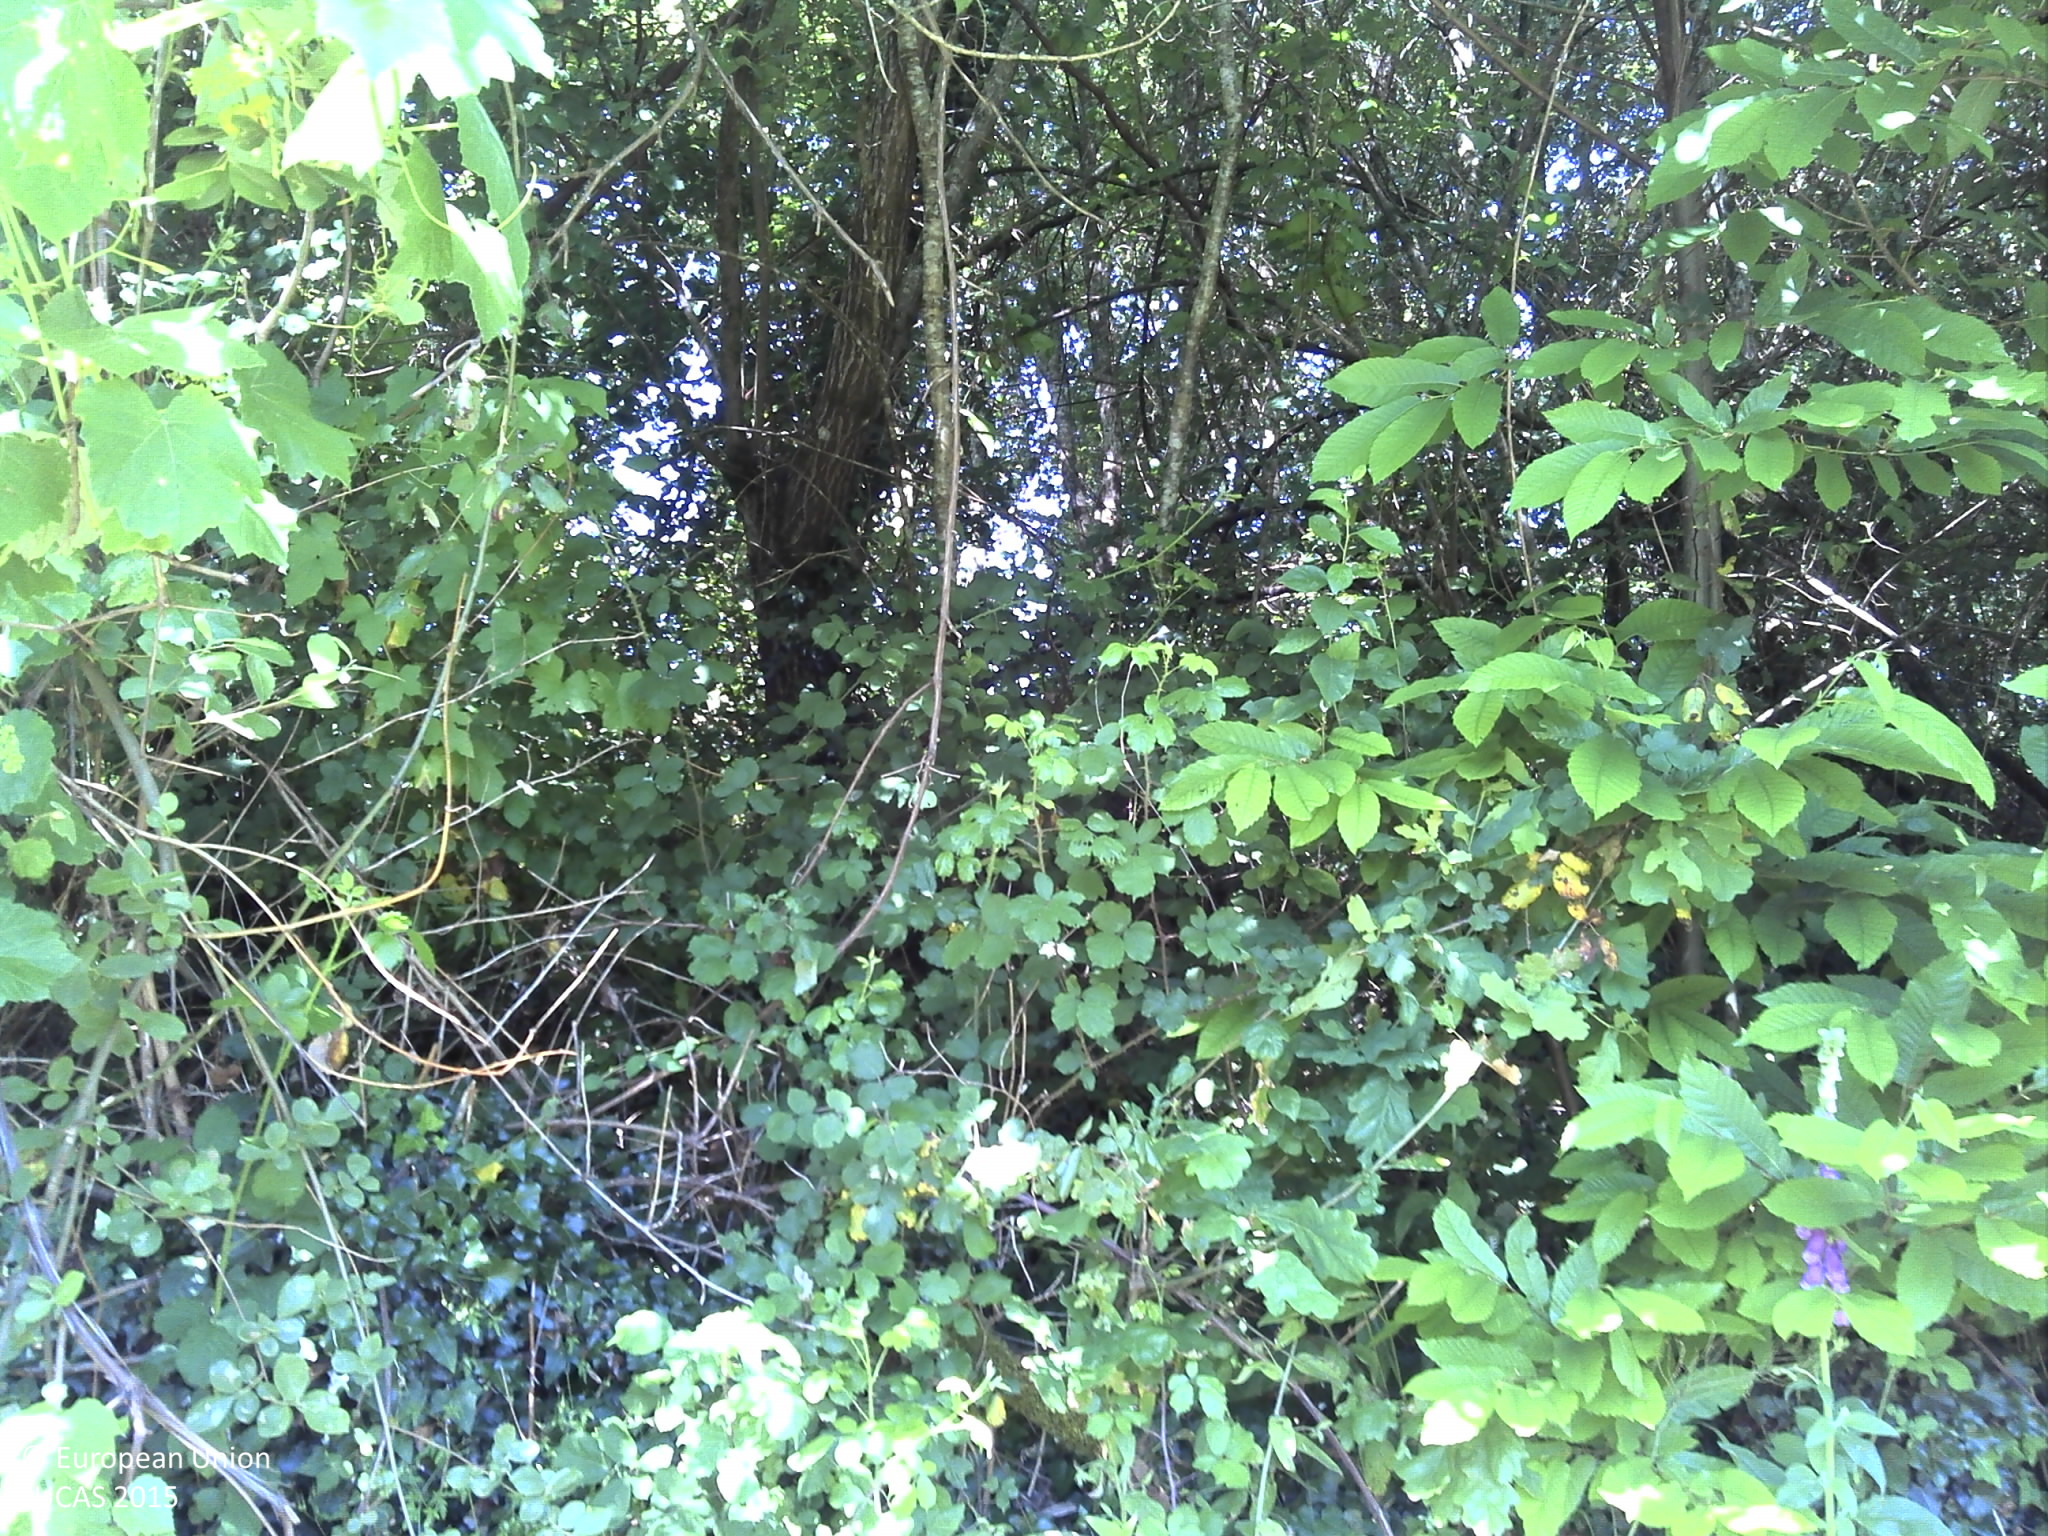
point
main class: Woodland
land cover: Broadleaved woodland
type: mesophytic deciduous forest
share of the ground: > 75 %
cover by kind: broadleaved forest trees 85 %, shrubs 5 %, herbaceous plants 5 %, unconsolidated bare surface 5 %
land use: Semi-natural and natural areas not in use
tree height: > 5 m
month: May
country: PT
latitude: 41.8982
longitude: -8.6692
